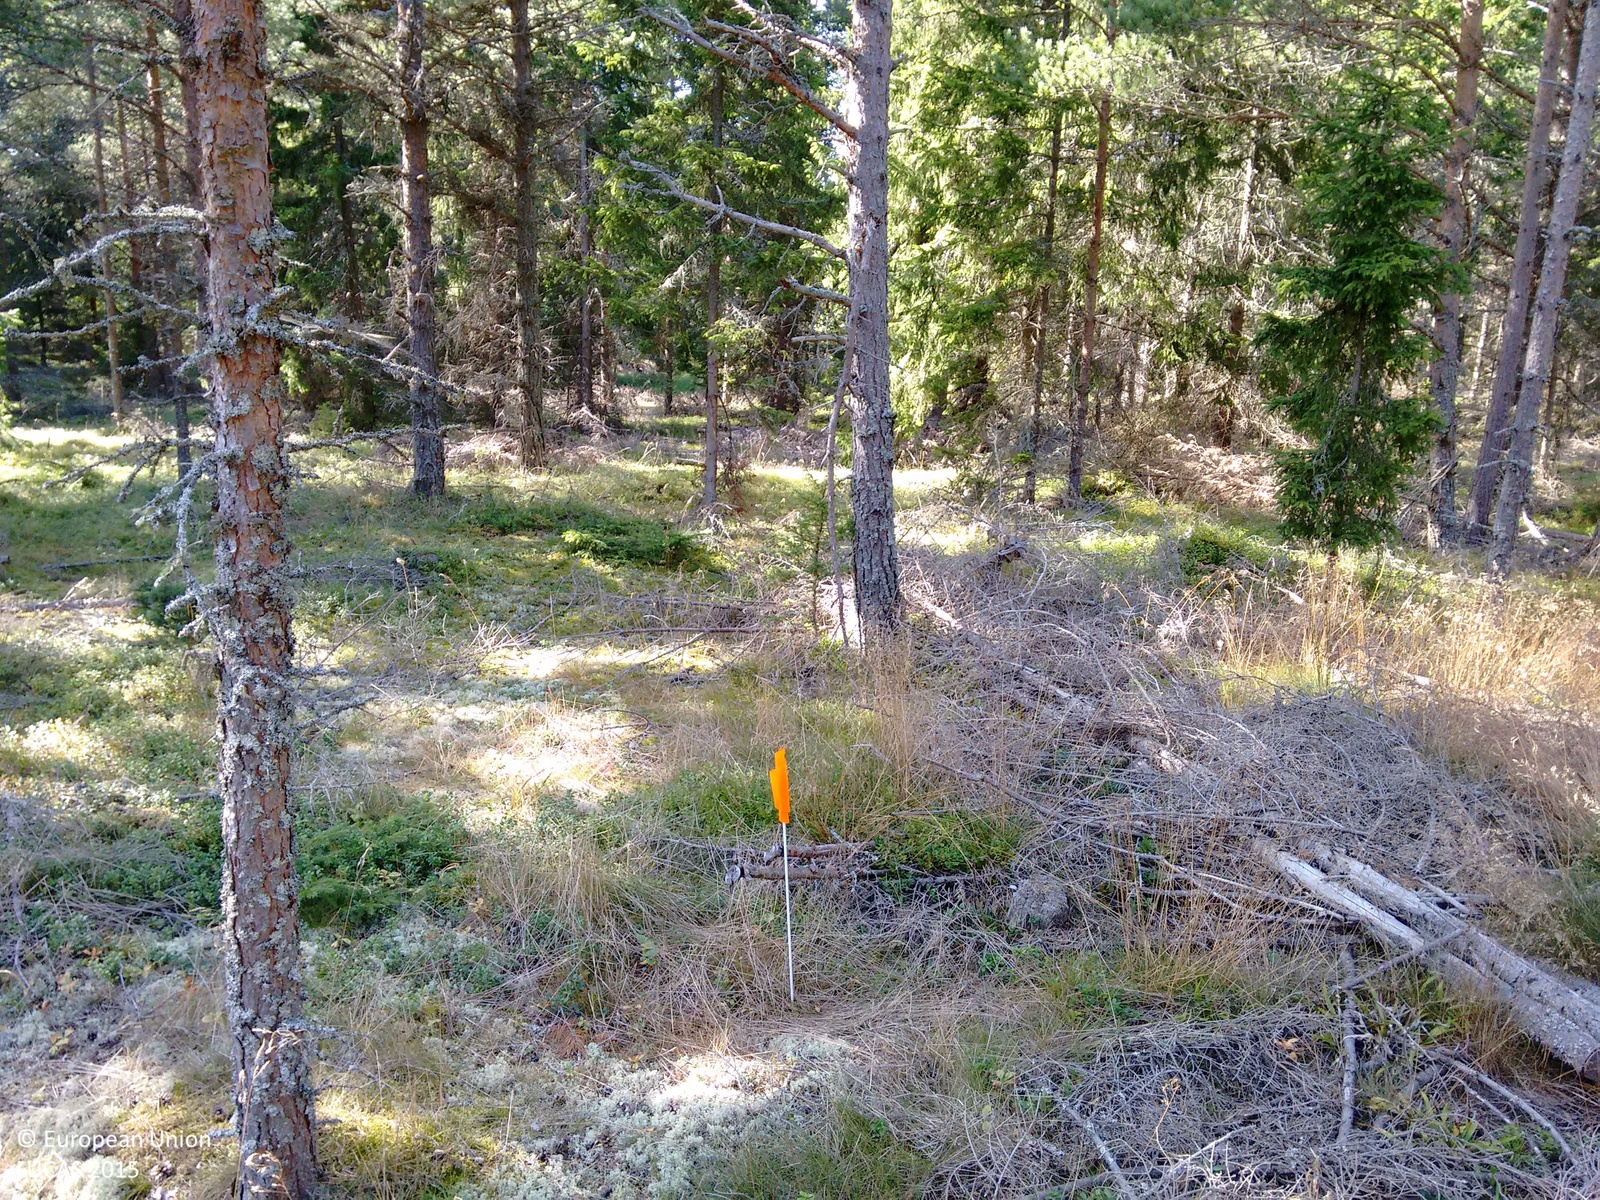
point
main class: Woodland
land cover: Pine dominated coniferous woodland
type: hemiboreal forest and nemoral coniferous forest and mixed broadleaved-coniferous forest
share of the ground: > 75 %
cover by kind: coniferous forest trees 80 %, lichens and mosses 15 %, herbaceous plants 5 %
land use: Forestry
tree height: > 5 m
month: August
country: FI
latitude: 60.2417
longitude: 19.4851
